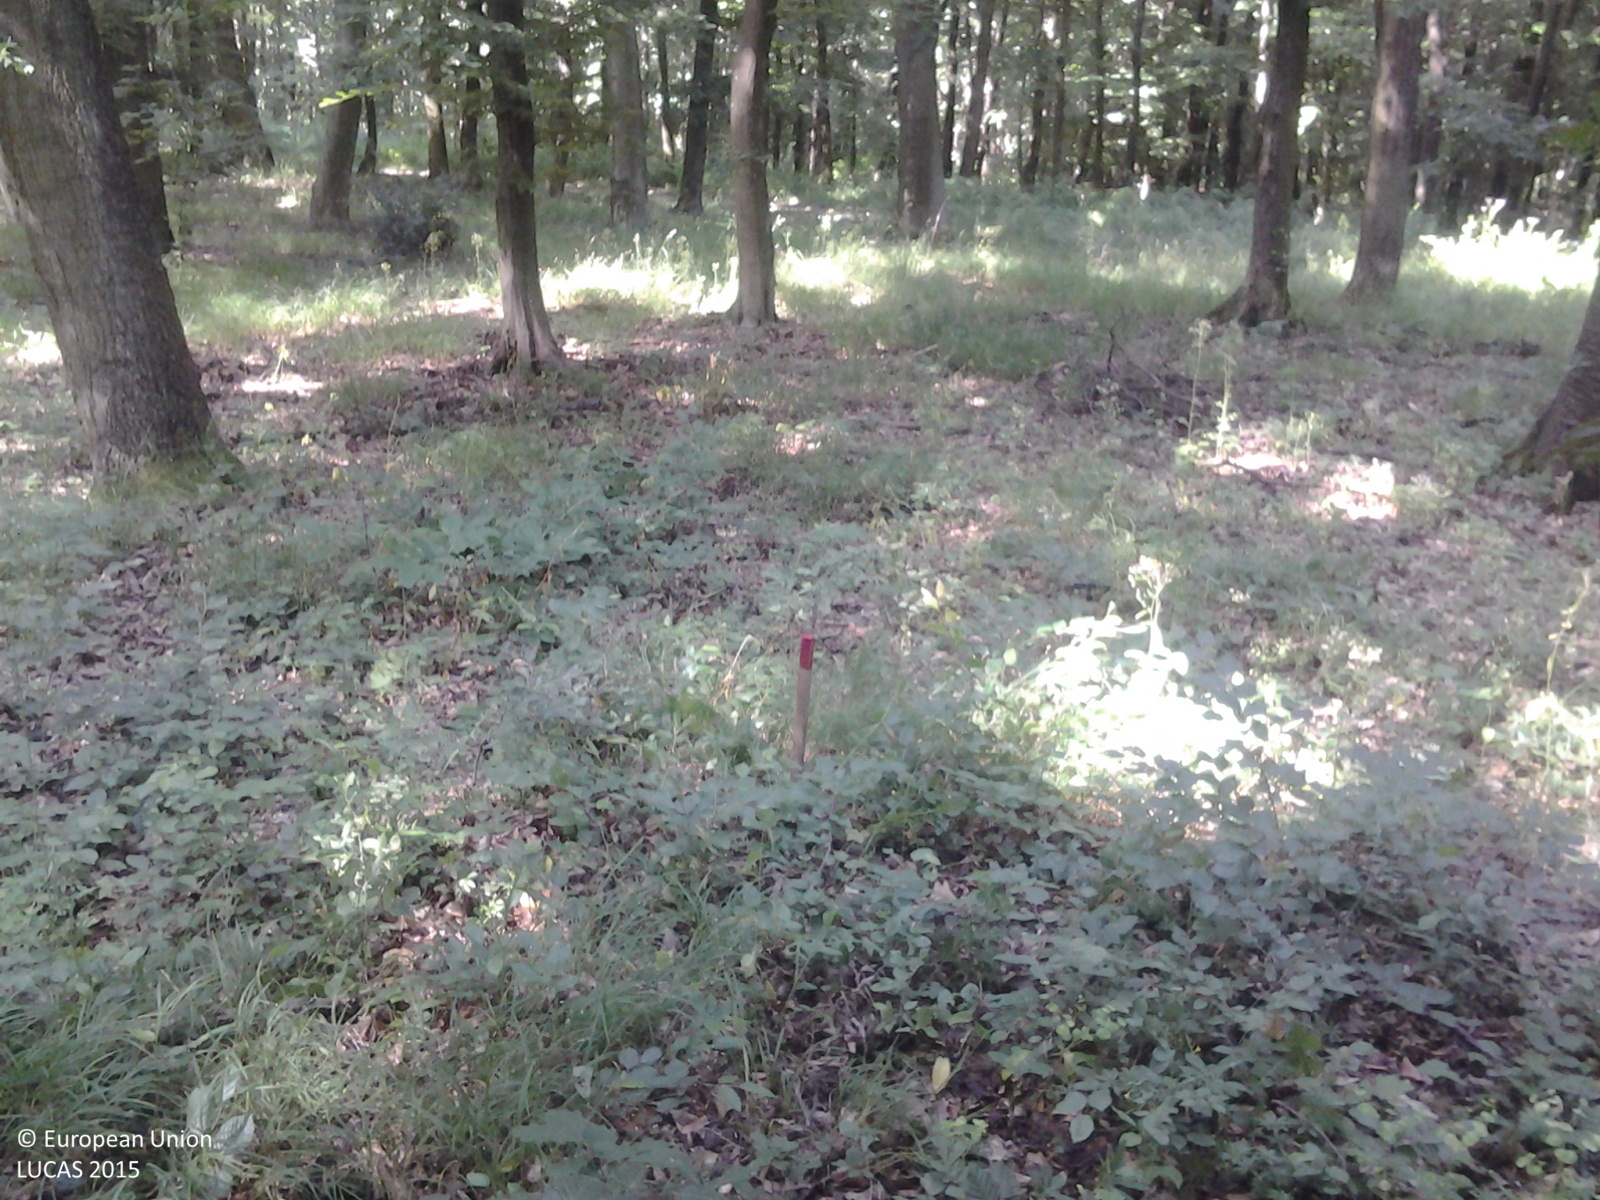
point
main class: Woodland
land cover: Broadleaved woodland
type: beech forest
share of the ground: > 75 %
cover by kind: broadleaved forest trees 100 %
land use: Forestry
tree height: > 5 m
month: June
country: HU
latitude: 46.8637
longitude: 17.2592
